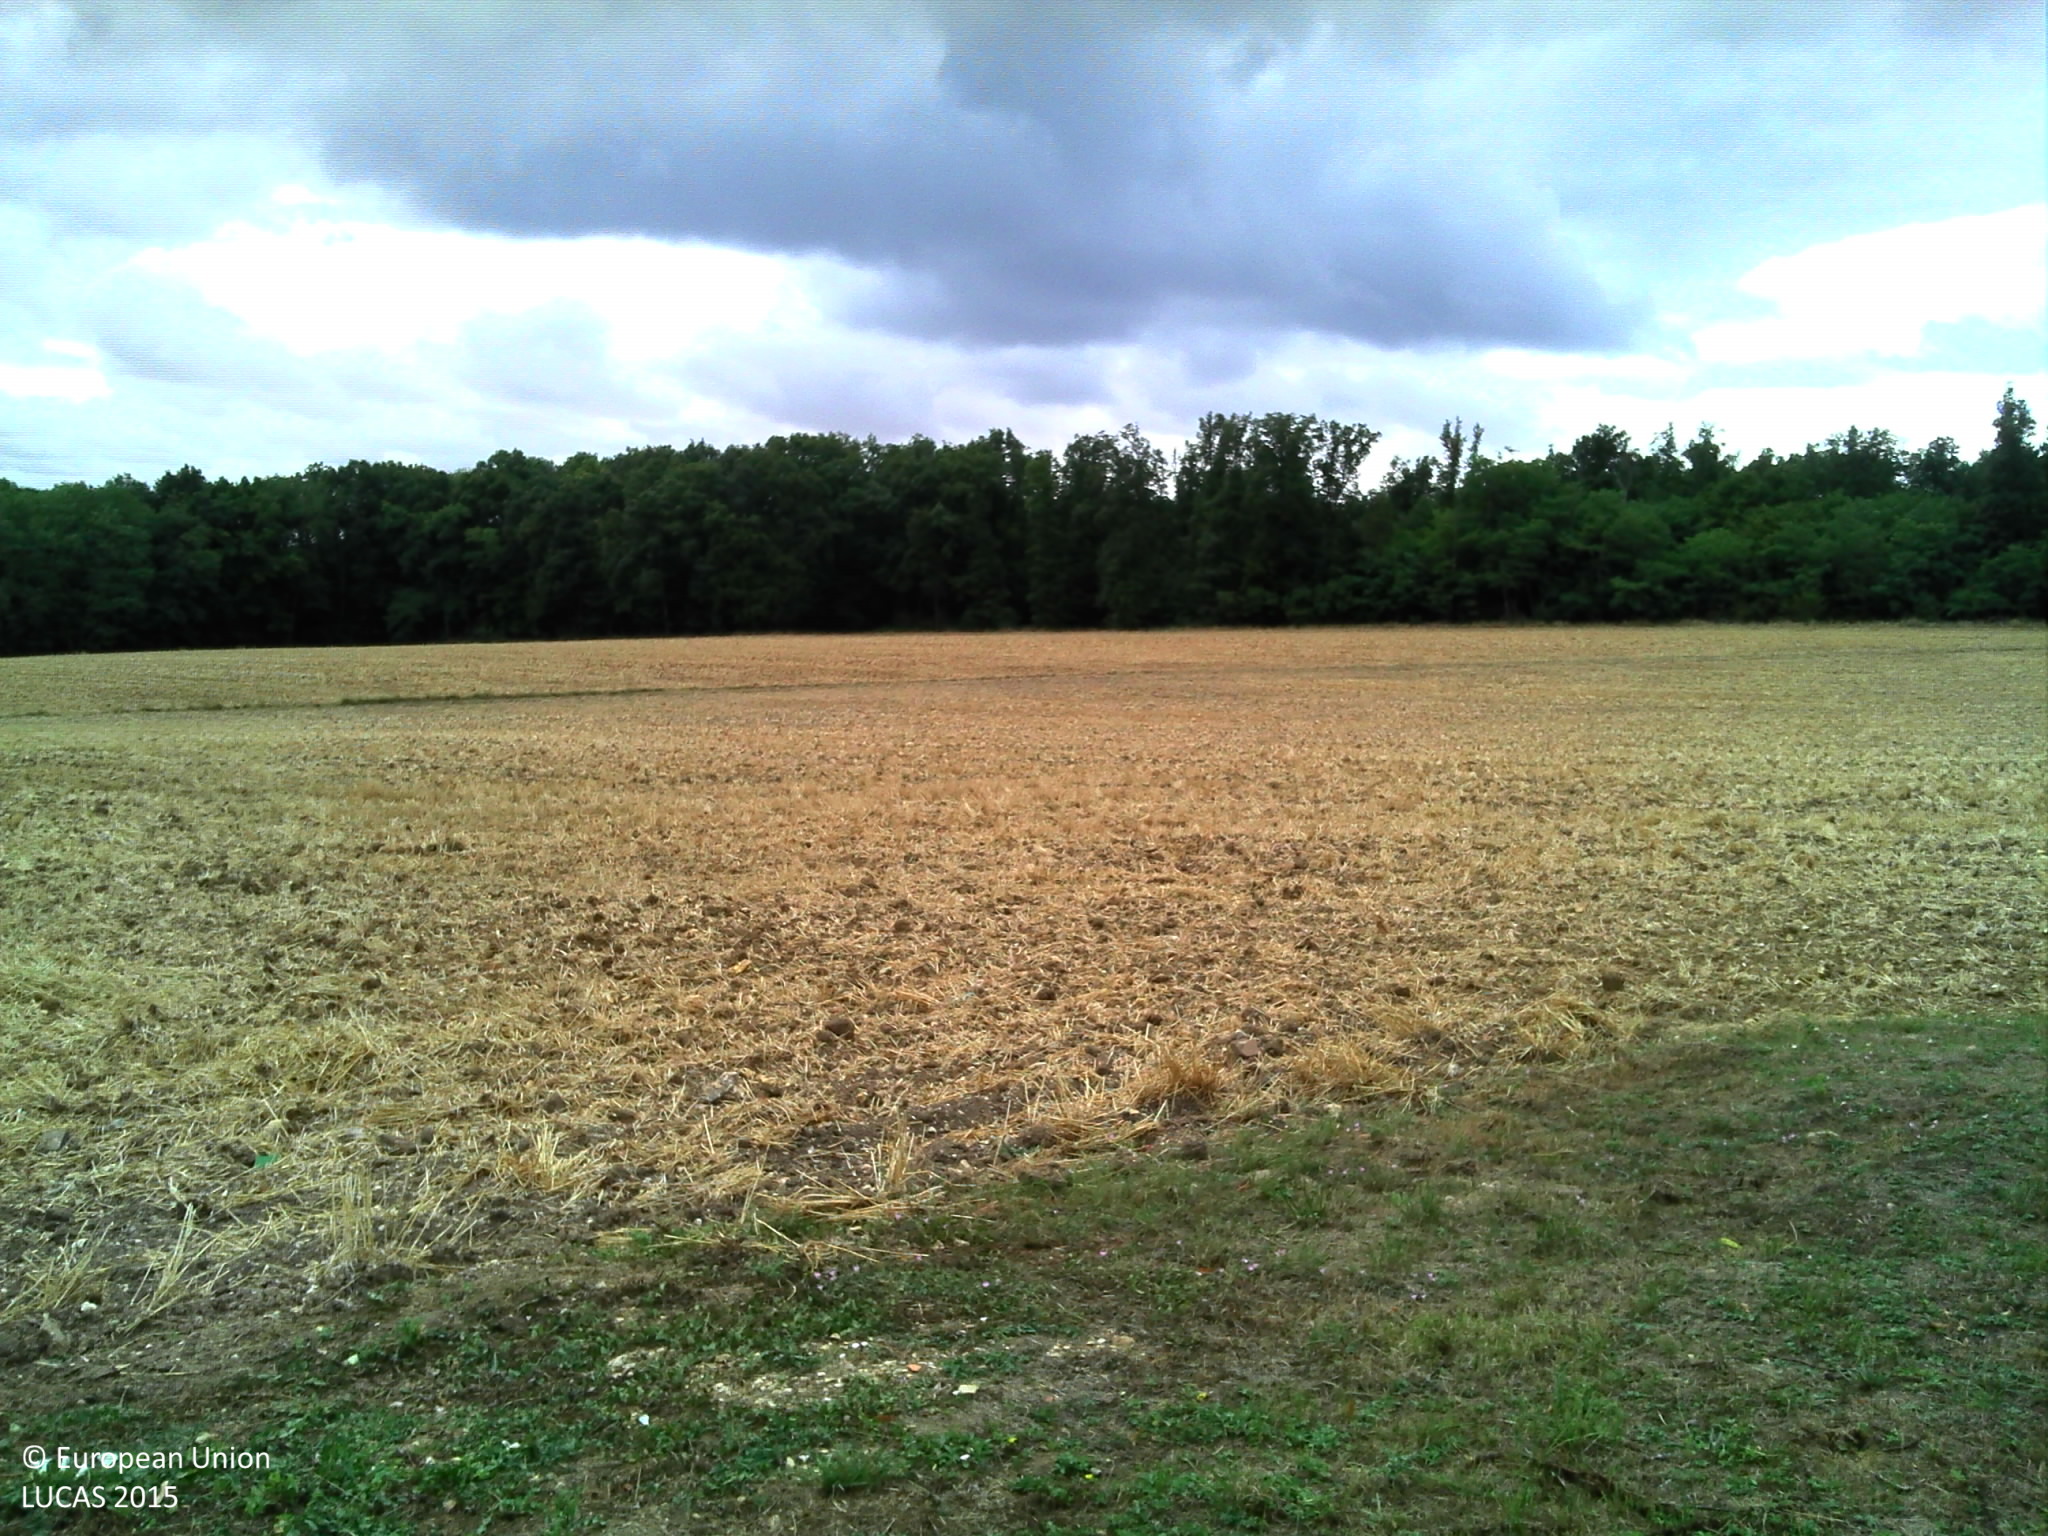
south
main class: Grassland
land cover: Grassland with sparse tree/shrub cover
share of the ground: > 75 %
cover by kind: herbaceous plants 90 %, broadleaved forest trees 5 %, shrubs 5 %
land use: Amenities, museums, leisure
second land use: Residential
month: July
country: FR
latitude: 48.0801
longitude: 3.4036
